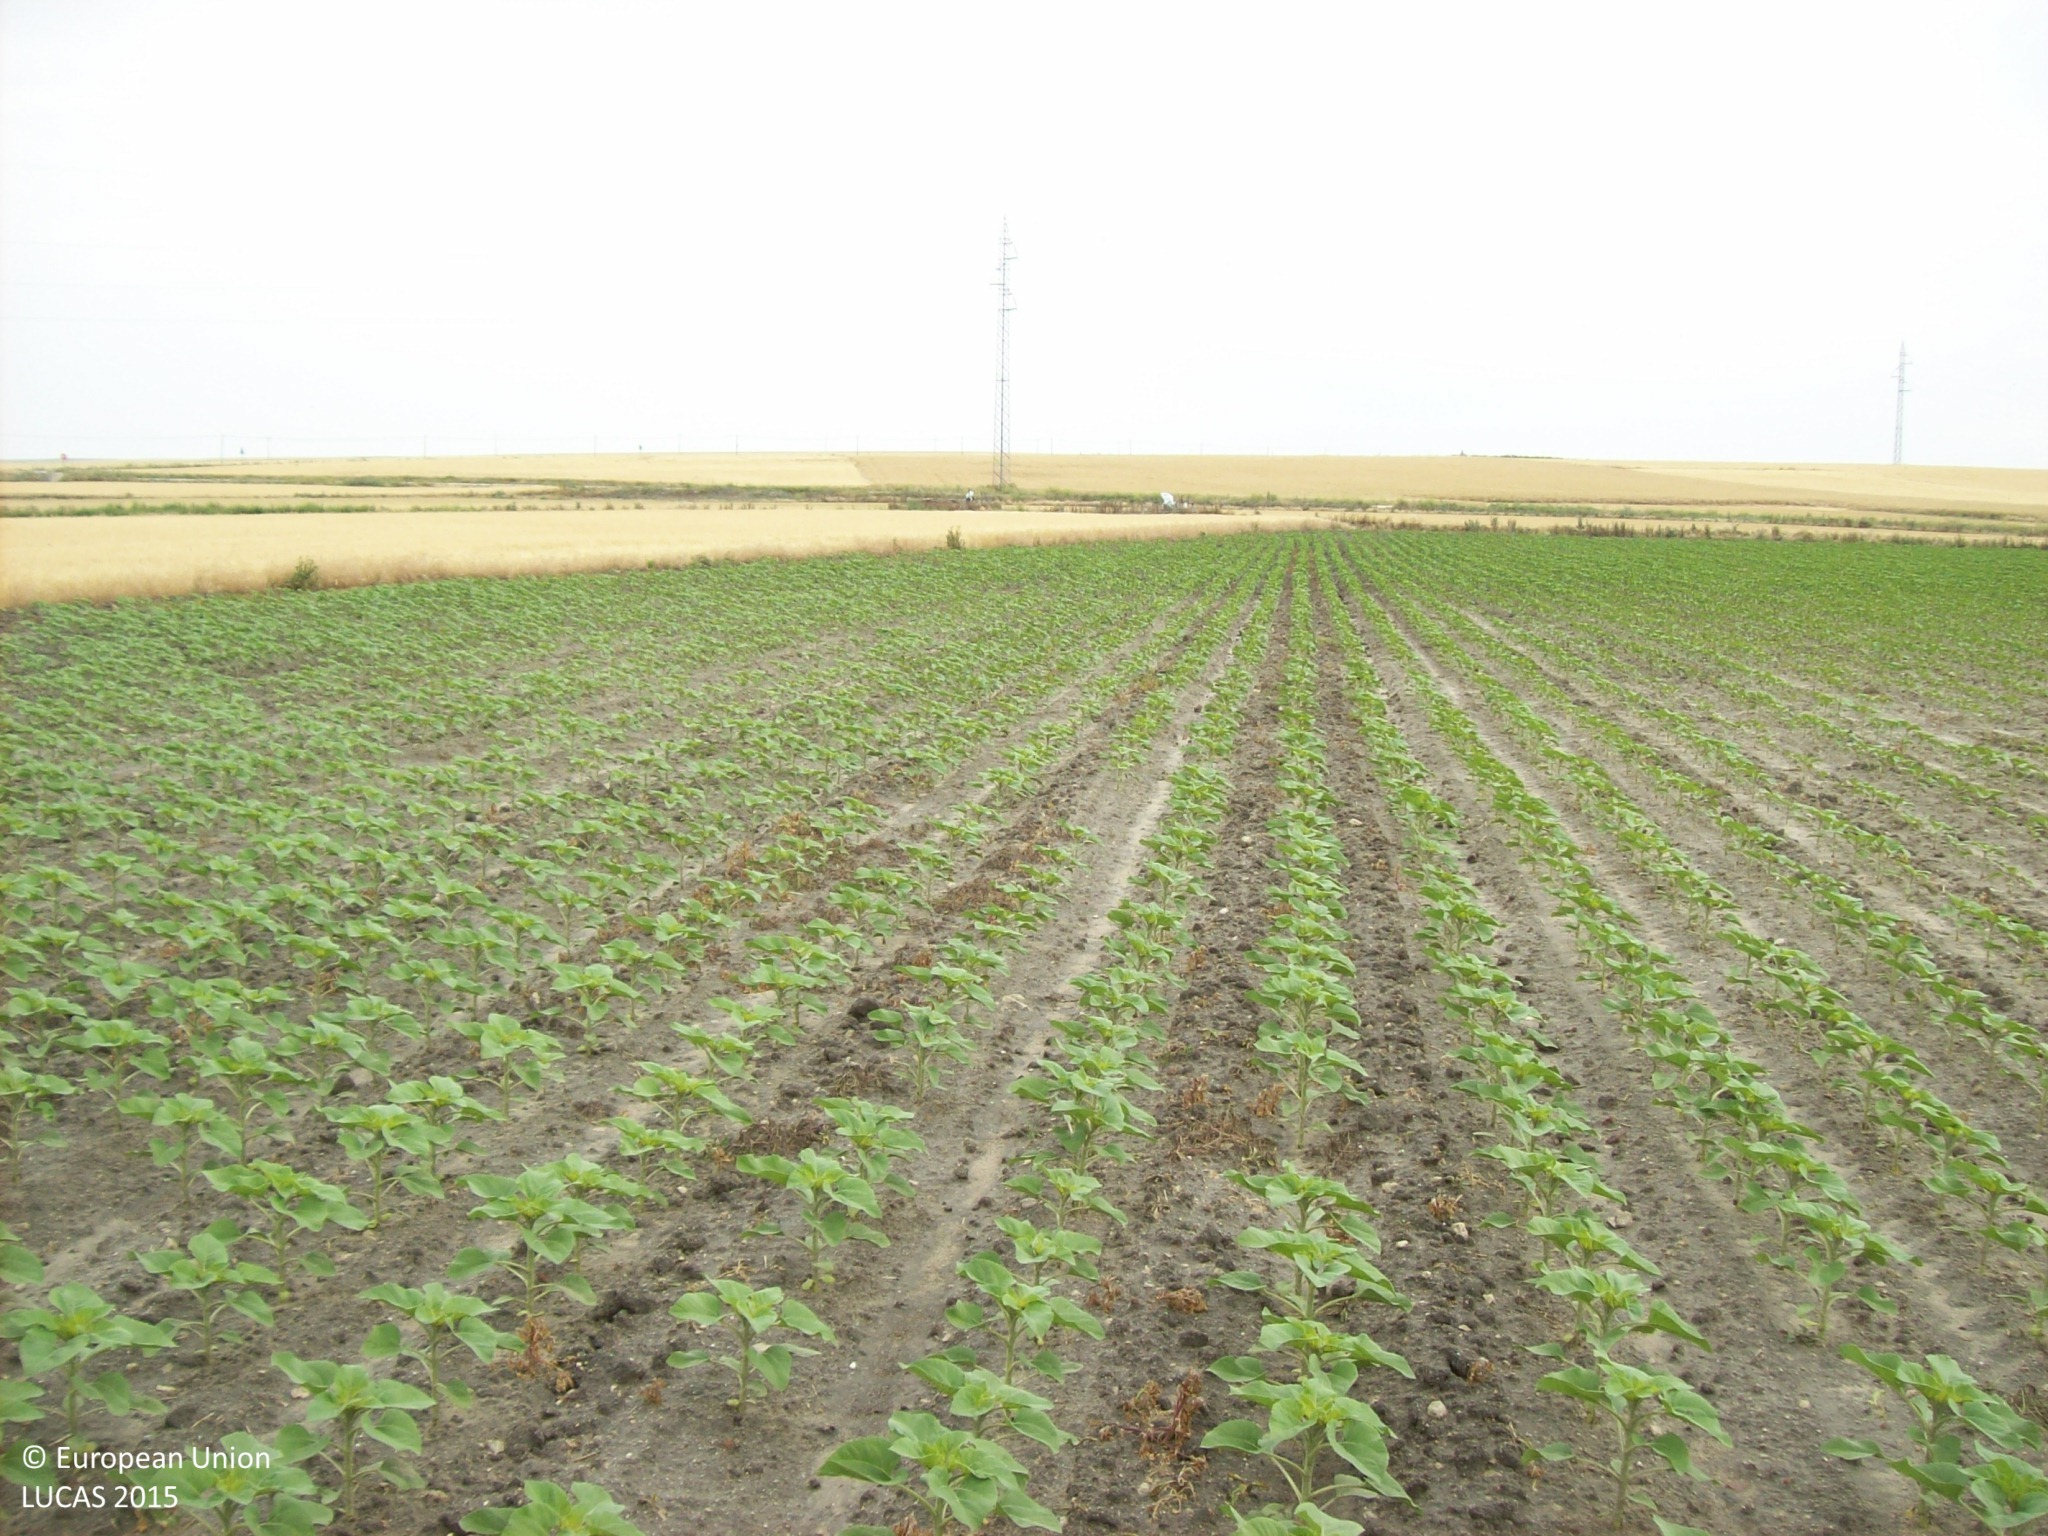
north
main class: Cropland
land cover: Sunflower
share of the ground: 50 - 75 %
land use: Agriculture (excluding fallow land and kitchen gardens)
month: June
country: ES
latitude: 40.9505
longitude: -4.9489
